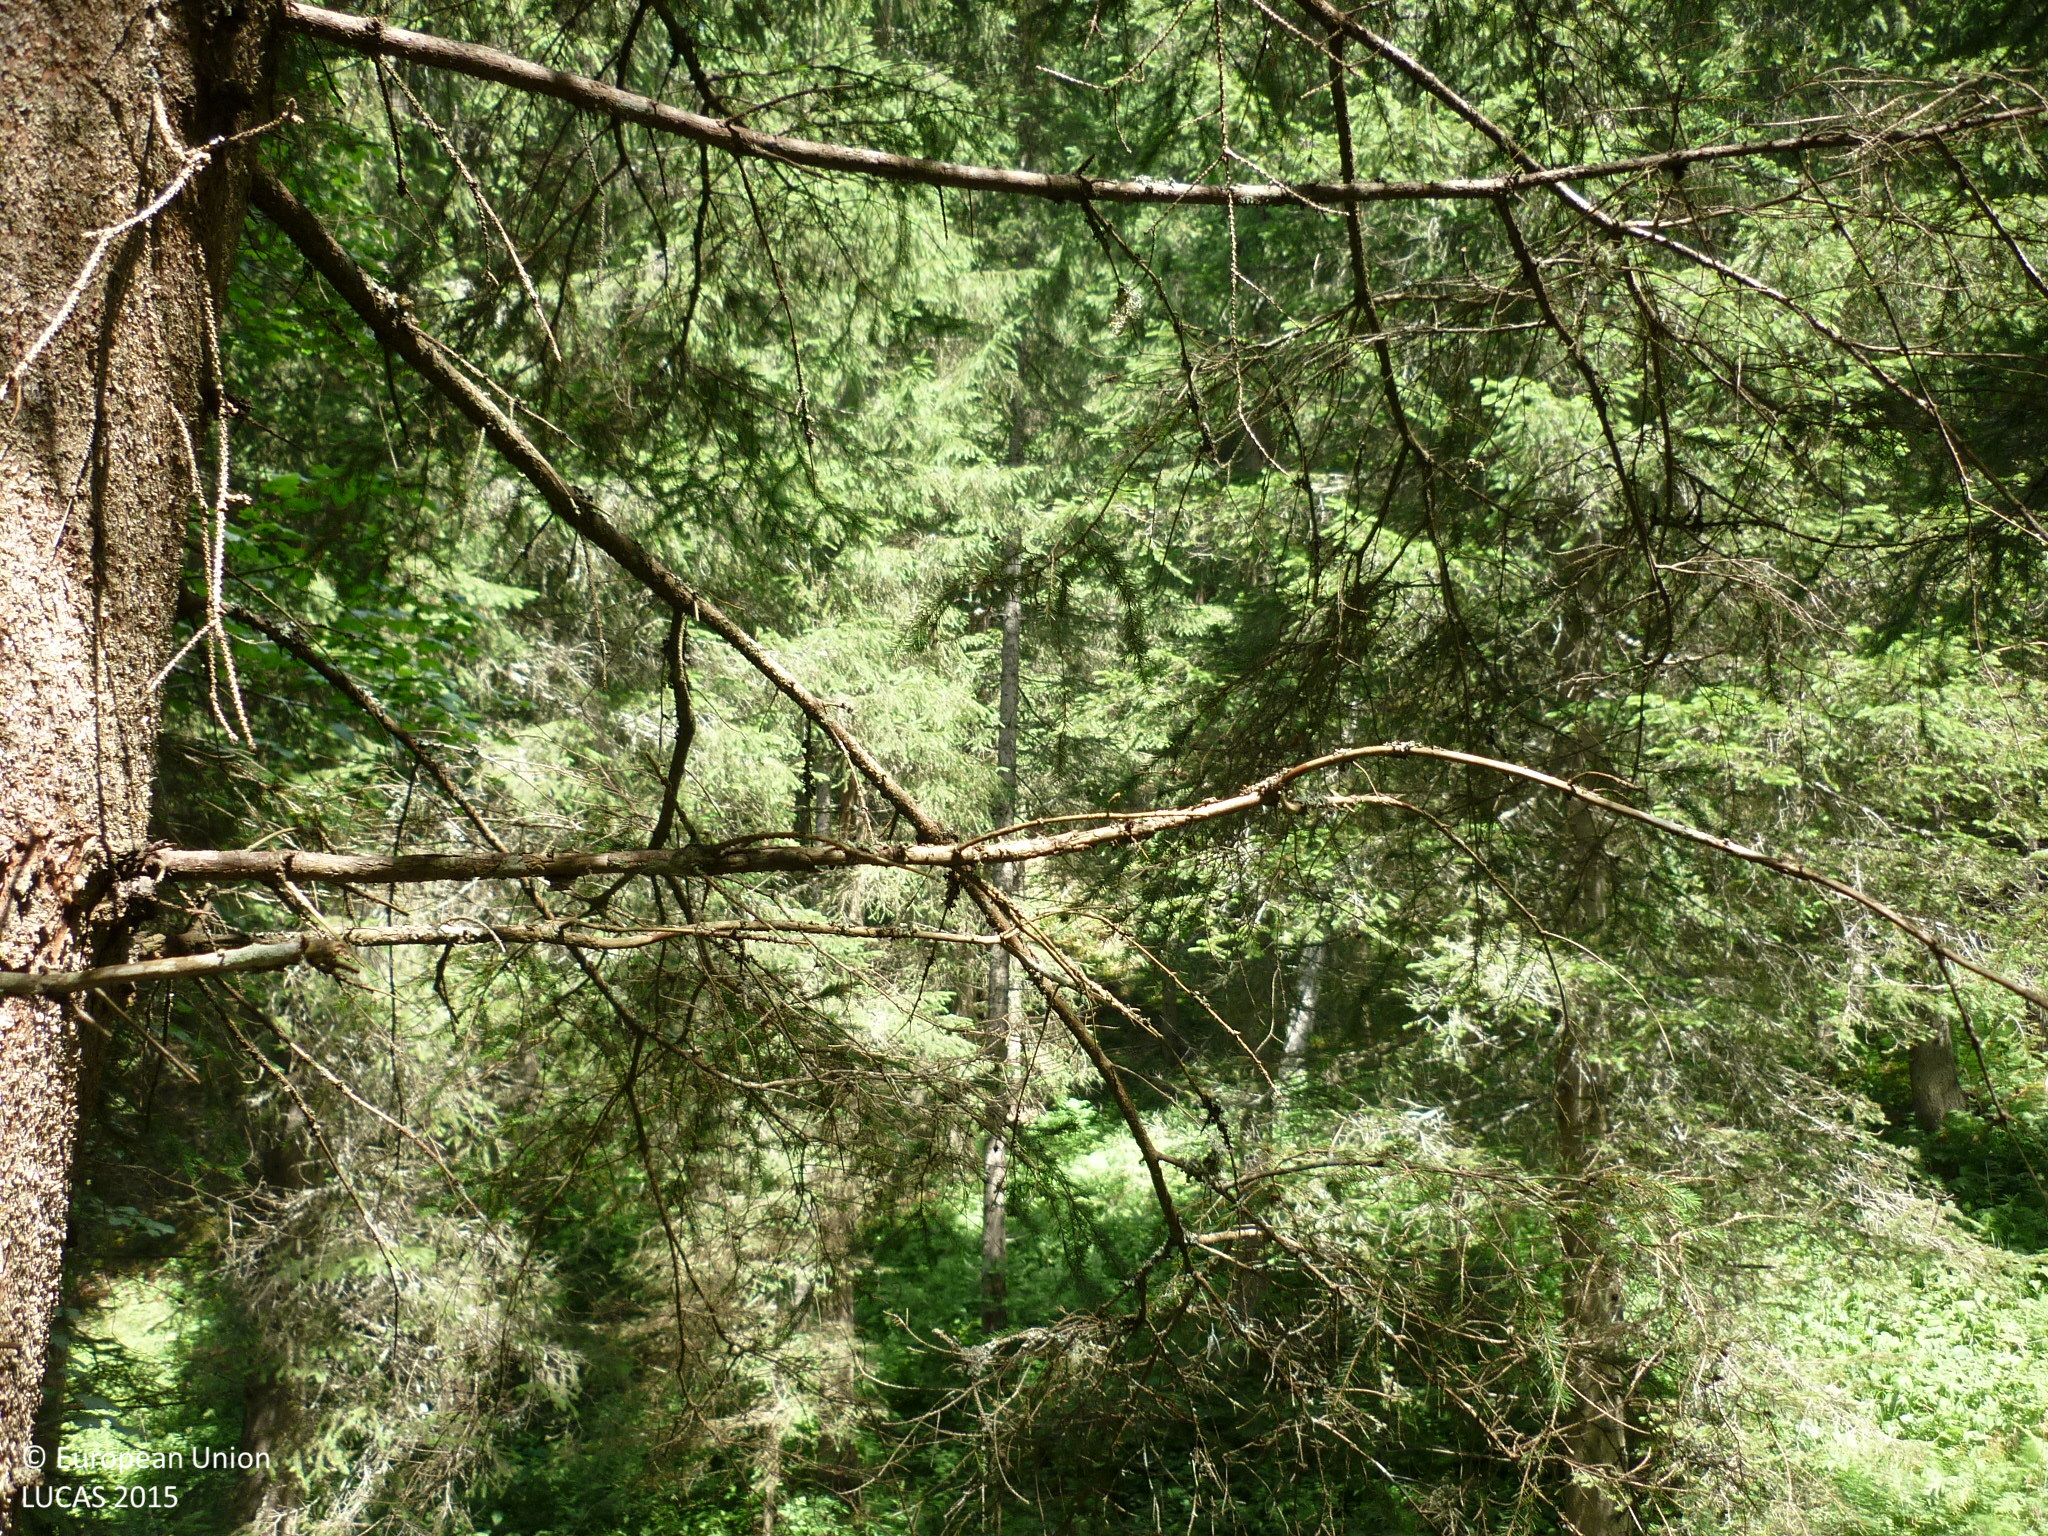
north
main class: Woodland
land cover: Spruce dominated coniferous woodland
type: alpine coniferous forest
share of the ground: > 75 %
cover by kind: coniferous forest trees 80 %, broadleaved forest trees 5 %, shrubs 5 %, herbaceous plants 5 %, lichens and mosses 5 %
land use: Forestry
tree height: > 5 m
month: July
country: AT
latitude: 47.0401
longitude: 14.3018
